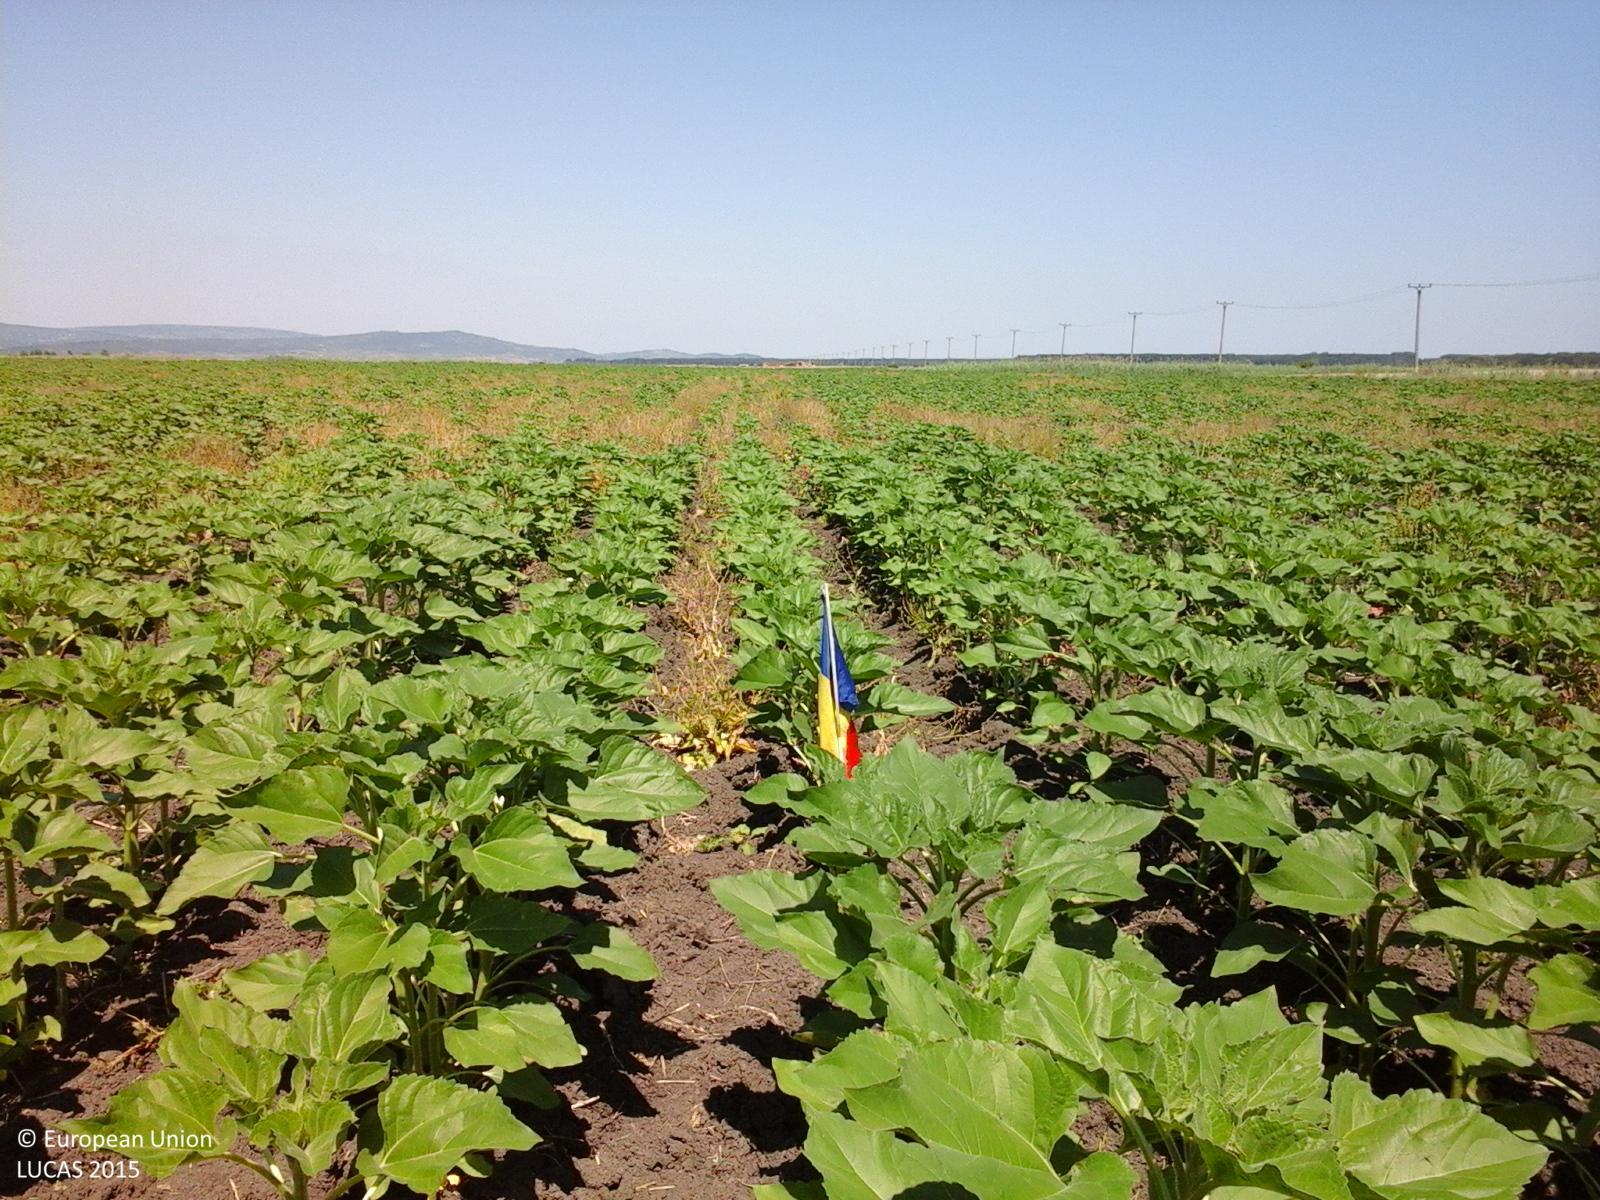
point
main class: Cropland
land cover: Sunflower
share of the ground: > 75 %
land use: Agriculture (excluding fallow land and kitchen gardens)
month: June
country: RO
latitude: 47.0316
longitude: 27.9325
